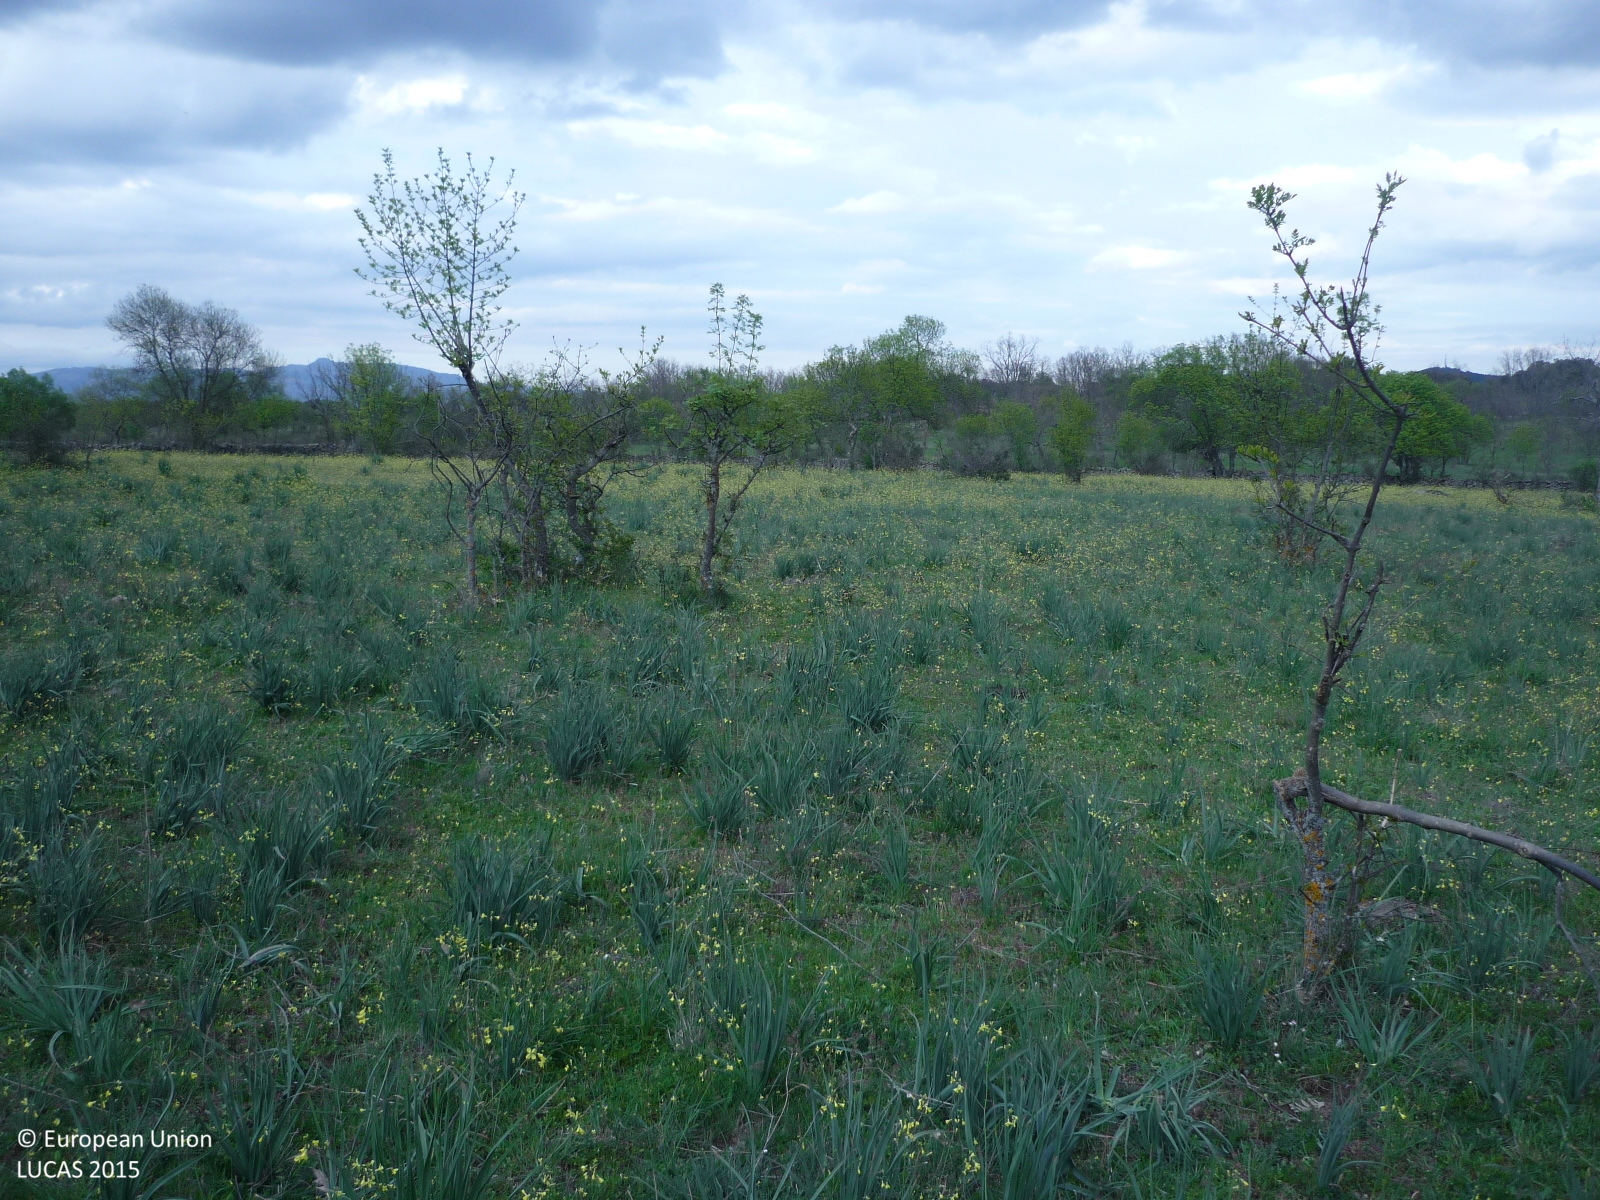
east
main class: Grassland
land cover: Grassland with sparse tree/shrub cover
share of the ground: > 75 %
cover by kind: herbaceous plants 85 %, shrubs 10 %, broadleaved forest trees 5 %
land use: Agriculture (excluding fallow land and kitchen gardens)
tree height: < 5 m
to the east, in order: Grassland with sparse tree/shrub cover; Dry stone walls; Broadleaved woodland
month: April
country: ES
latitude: 40.9892
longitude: -3.6783
